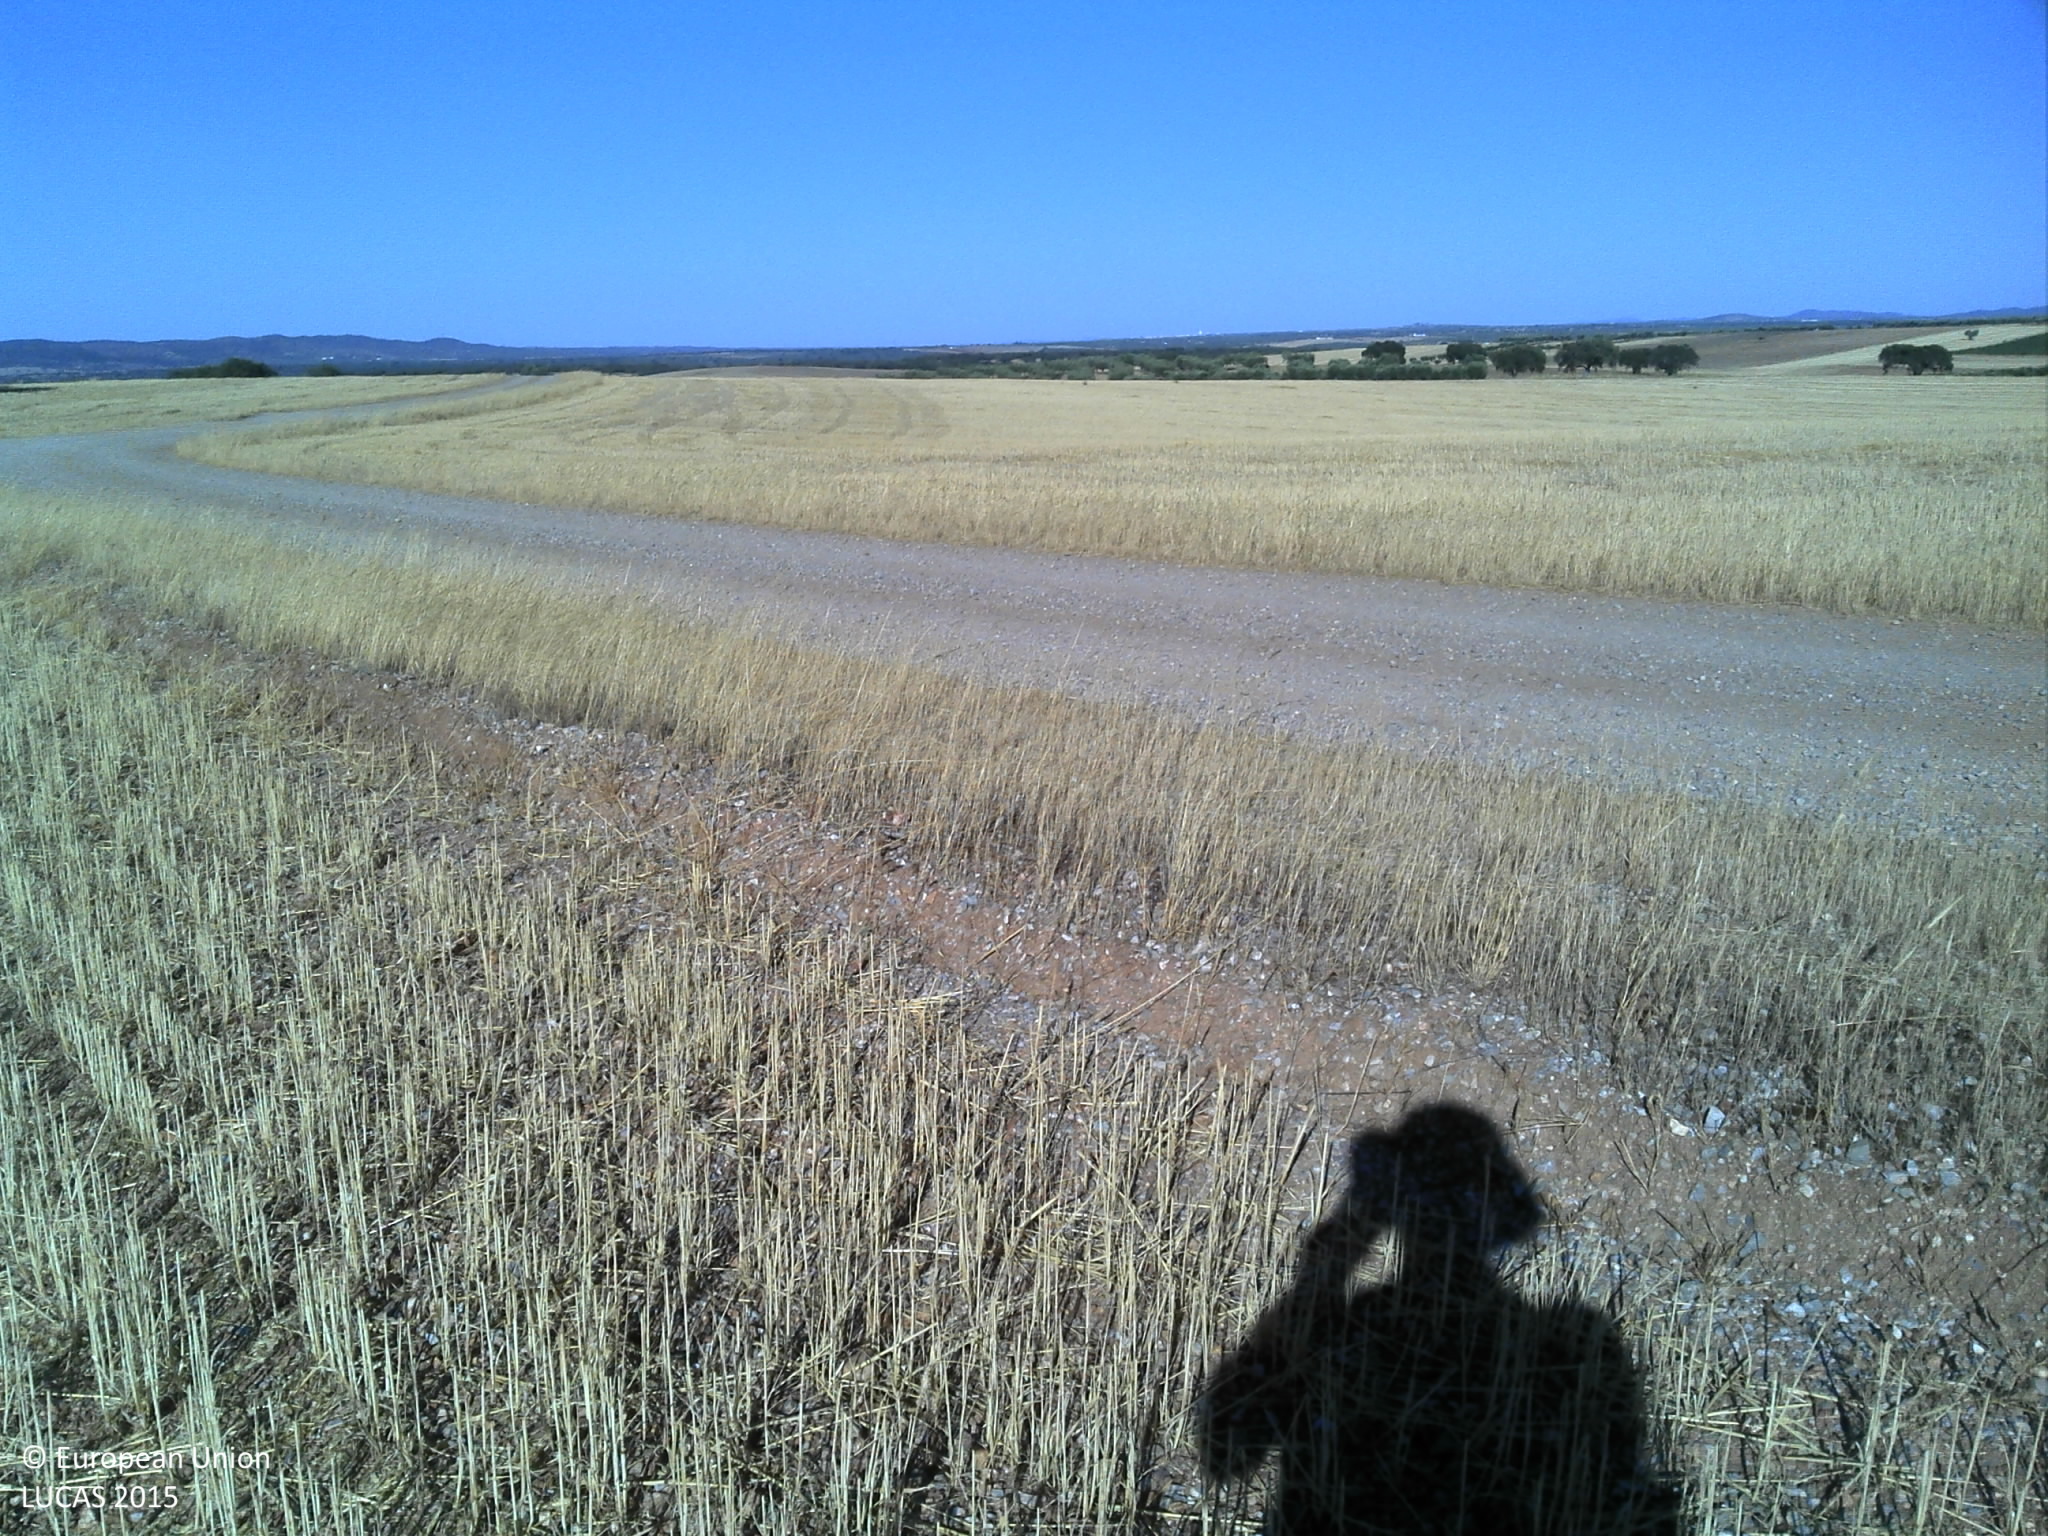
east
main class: Cropland
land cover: Common wheat
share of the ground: 25 - 50 %
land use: Agriculture (excluding fallow land and kitchen gardens)
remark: Harvested field
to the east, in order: Common wheat; Tracks; Common wheat
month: July
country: PT
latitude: 38.1351
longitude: -7.6520
